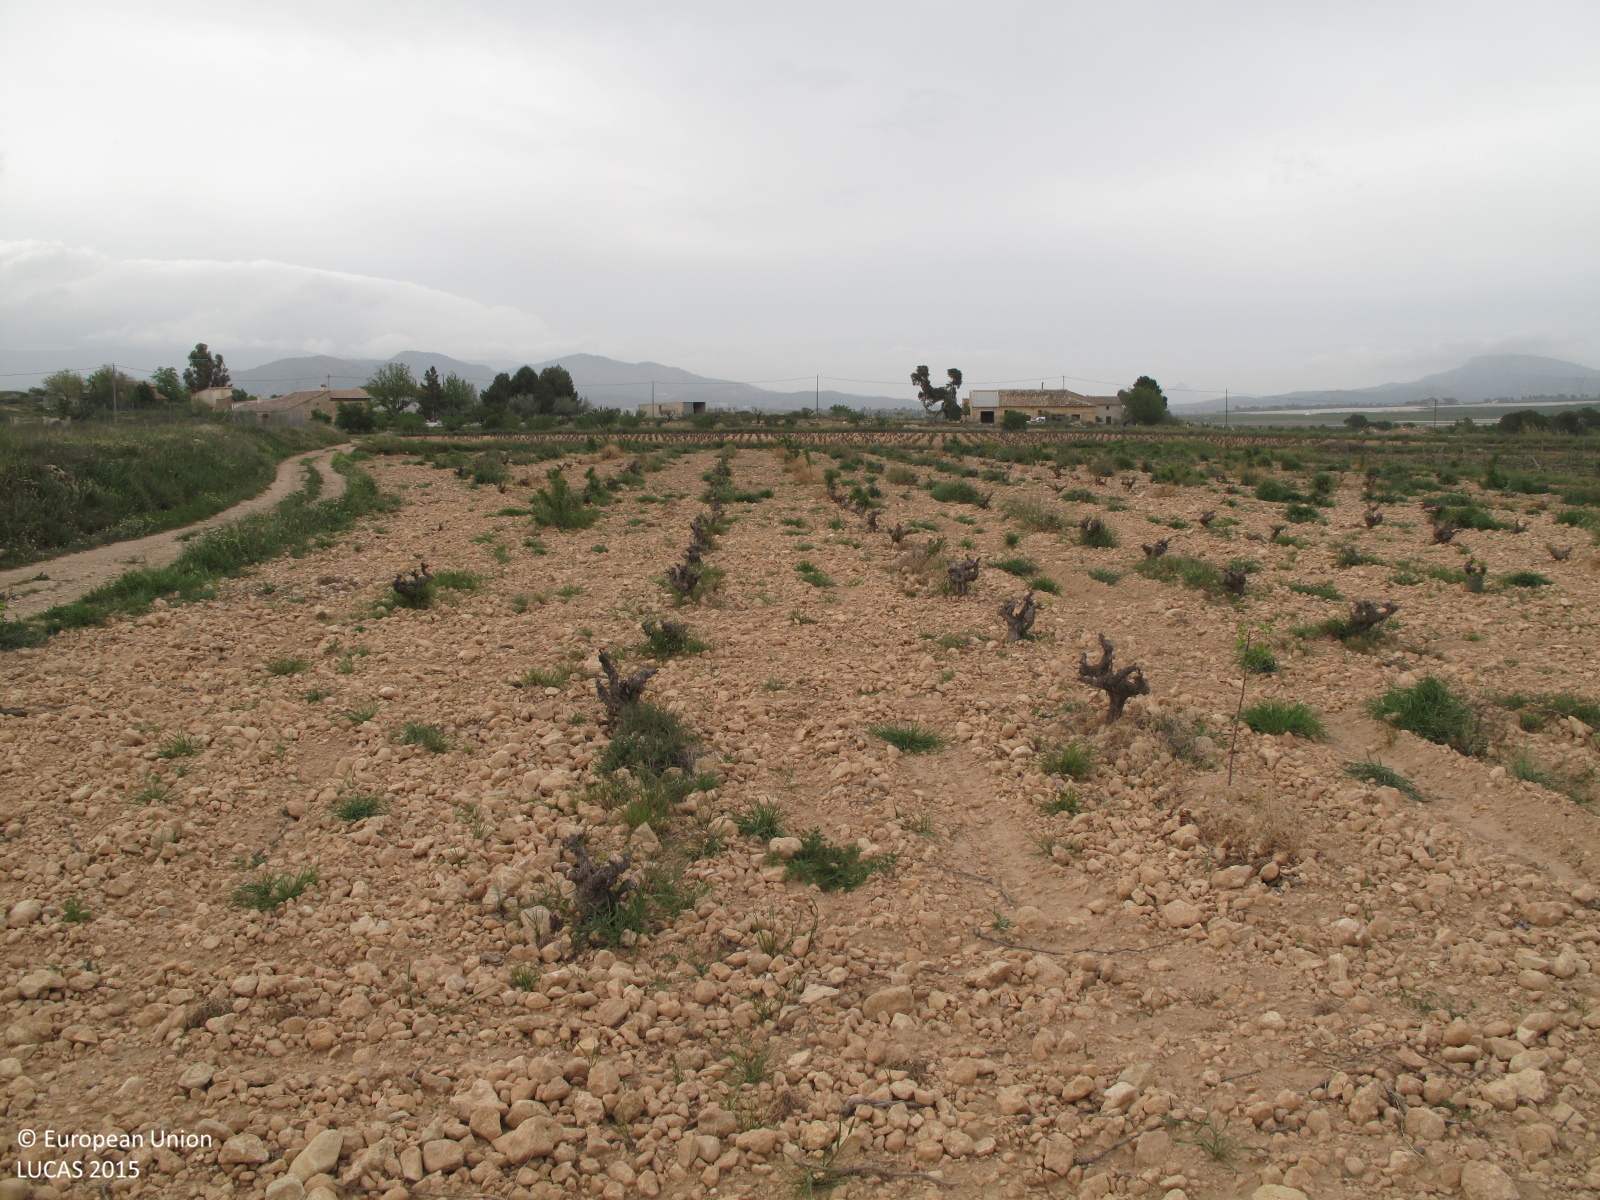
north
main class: Cropland
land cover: Vineyards
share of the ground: < 10 %
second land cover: Nuts trees
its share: < 10 %
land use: Agriculture (excluding fallow land and kitchen gardens)
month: April
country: ES
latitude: 38.4139
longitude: -0.9254
